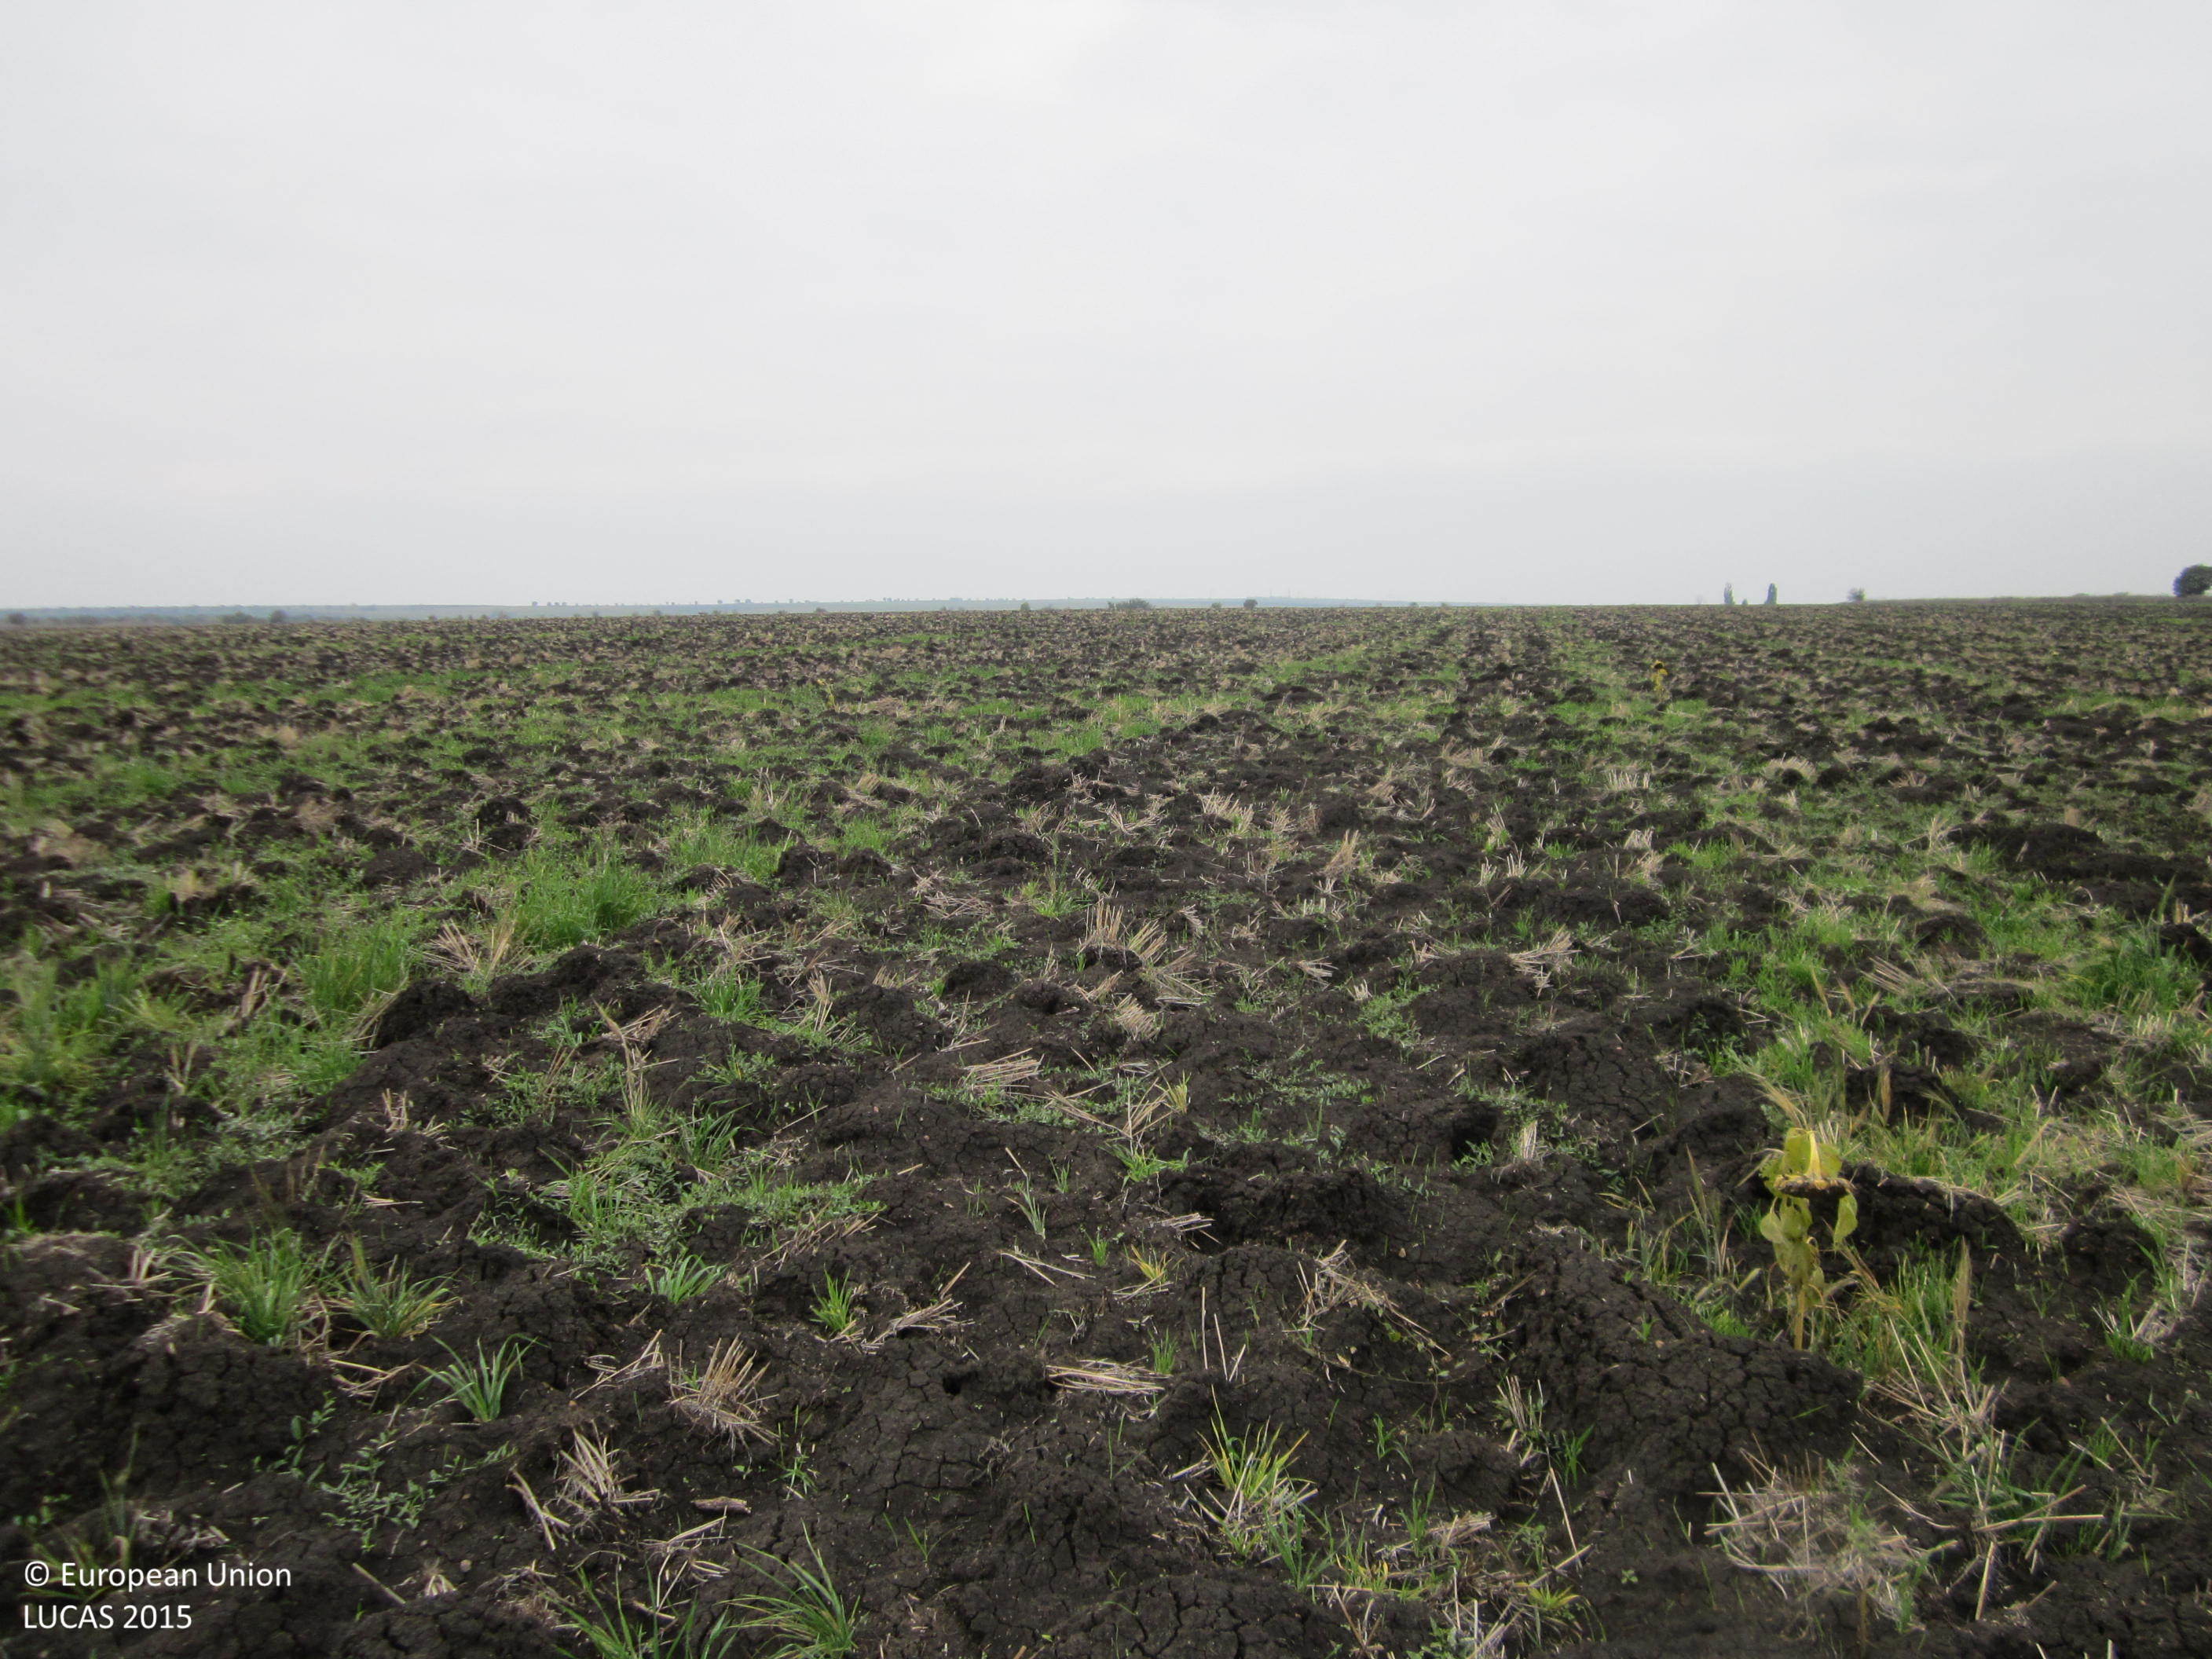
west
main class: Cropland
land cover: Barley
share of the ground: < 10 %
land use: Agriculture (excluding fallow land and kitchen gardens)
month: October
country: BG
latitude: 42.5476
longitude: 27.2208
